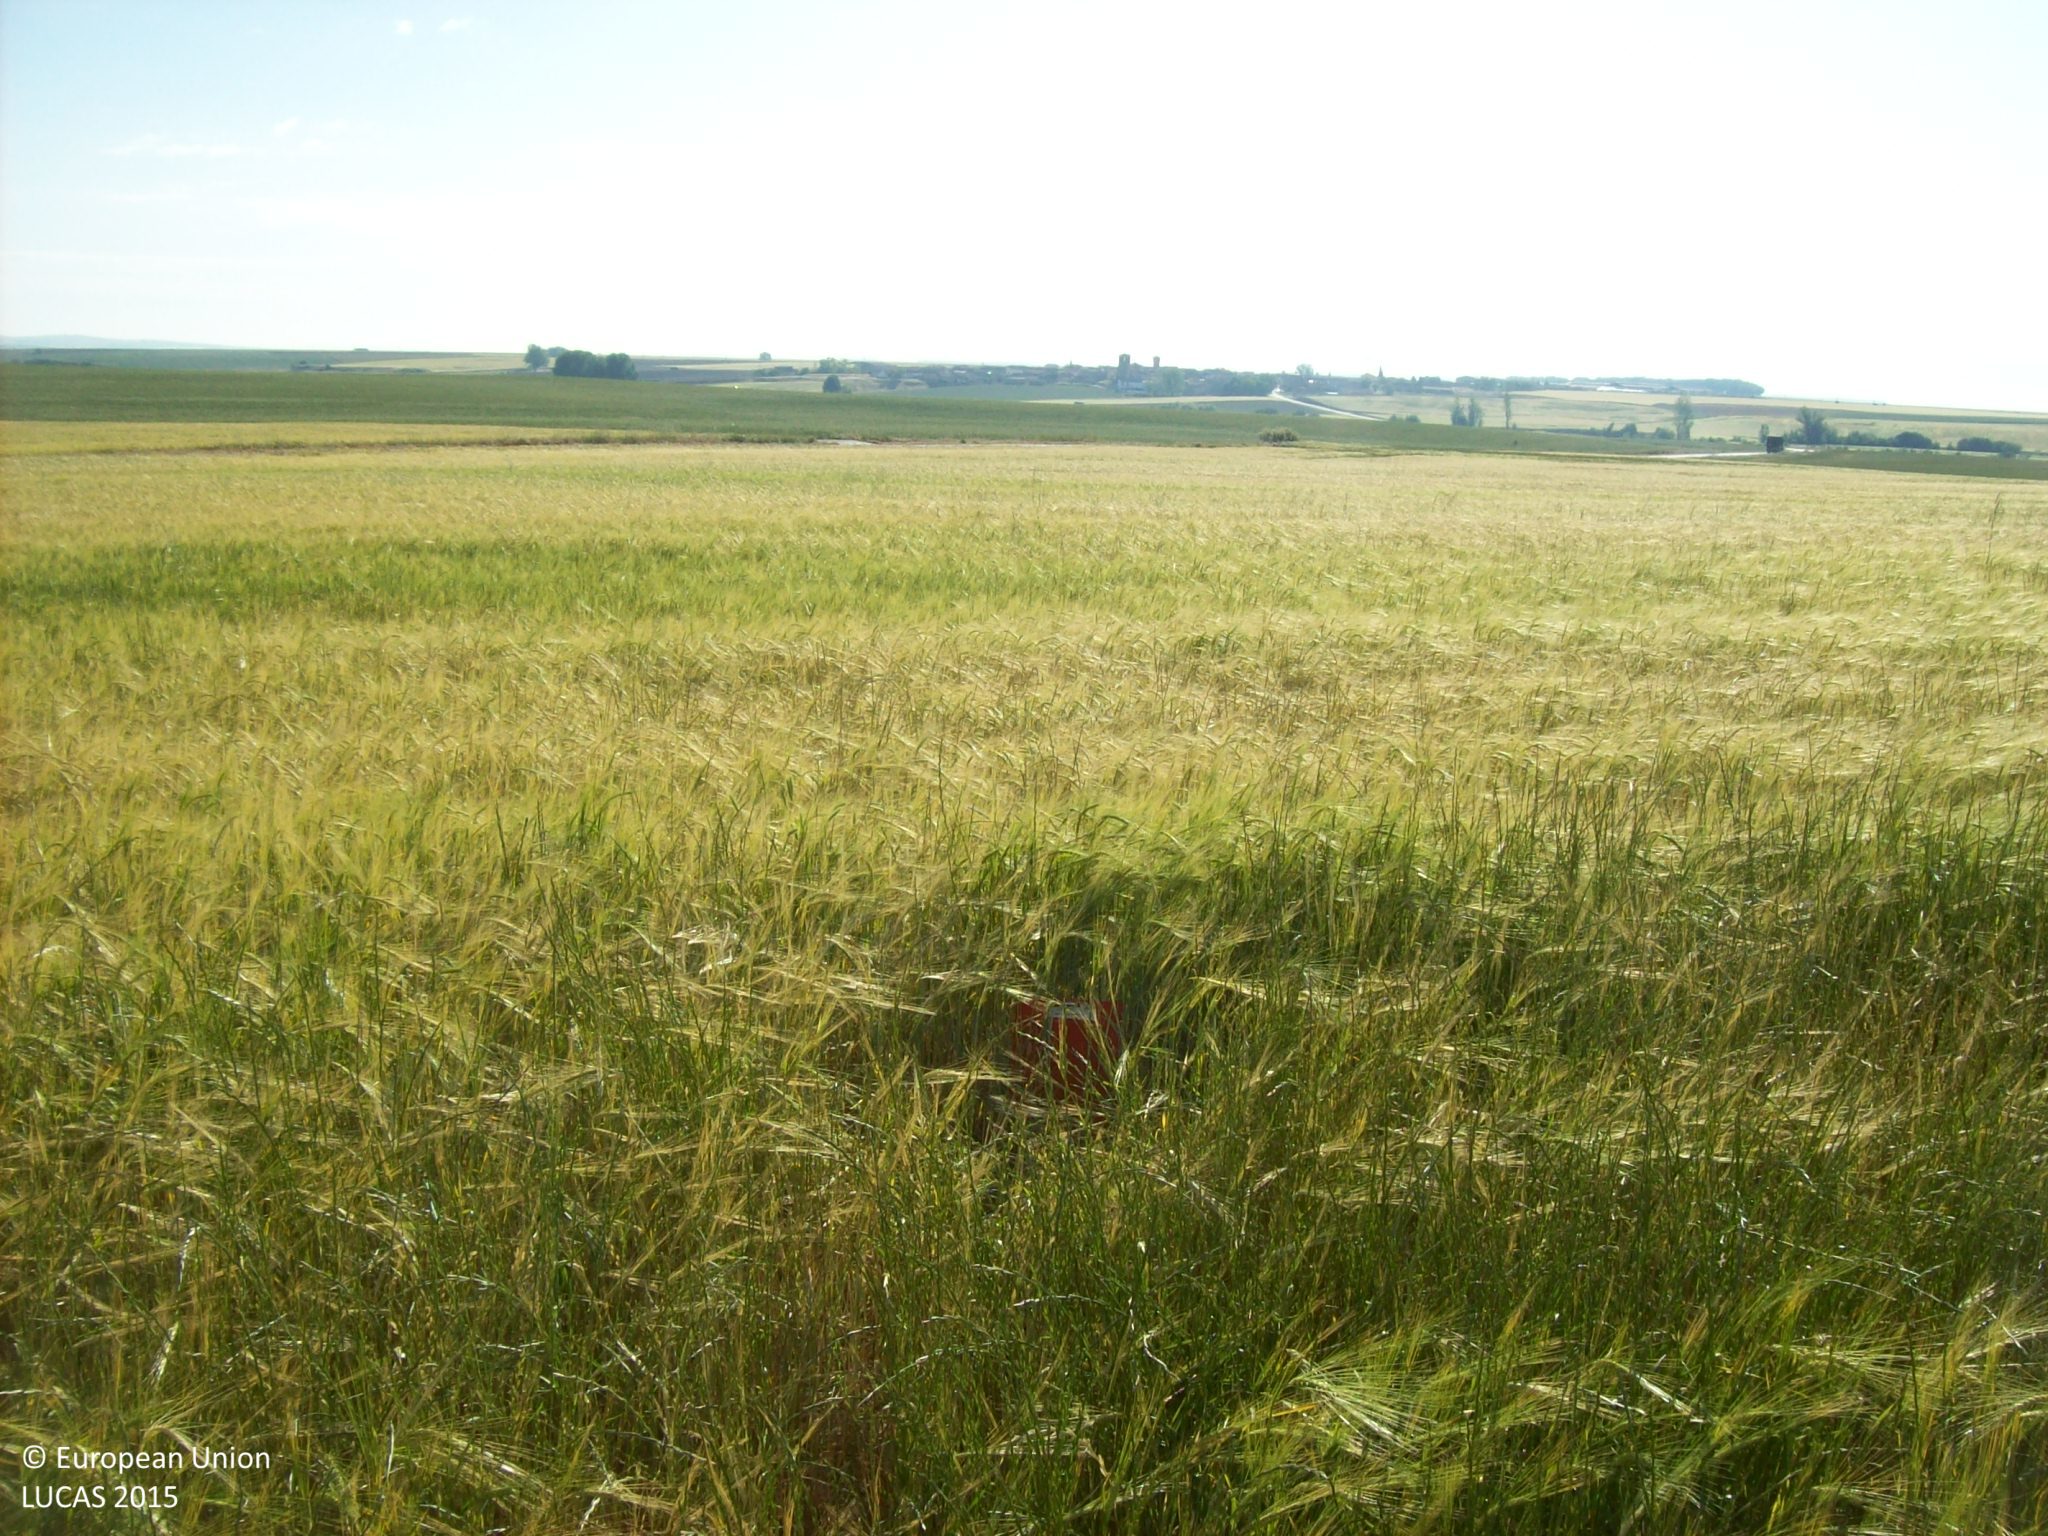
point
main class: Cropland
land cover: Barley
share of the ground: > 75 %
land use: Agriculture (excluding fallow land and kitchen gardens)
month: May
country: ES
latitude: 40.9428
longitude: -4.5121
